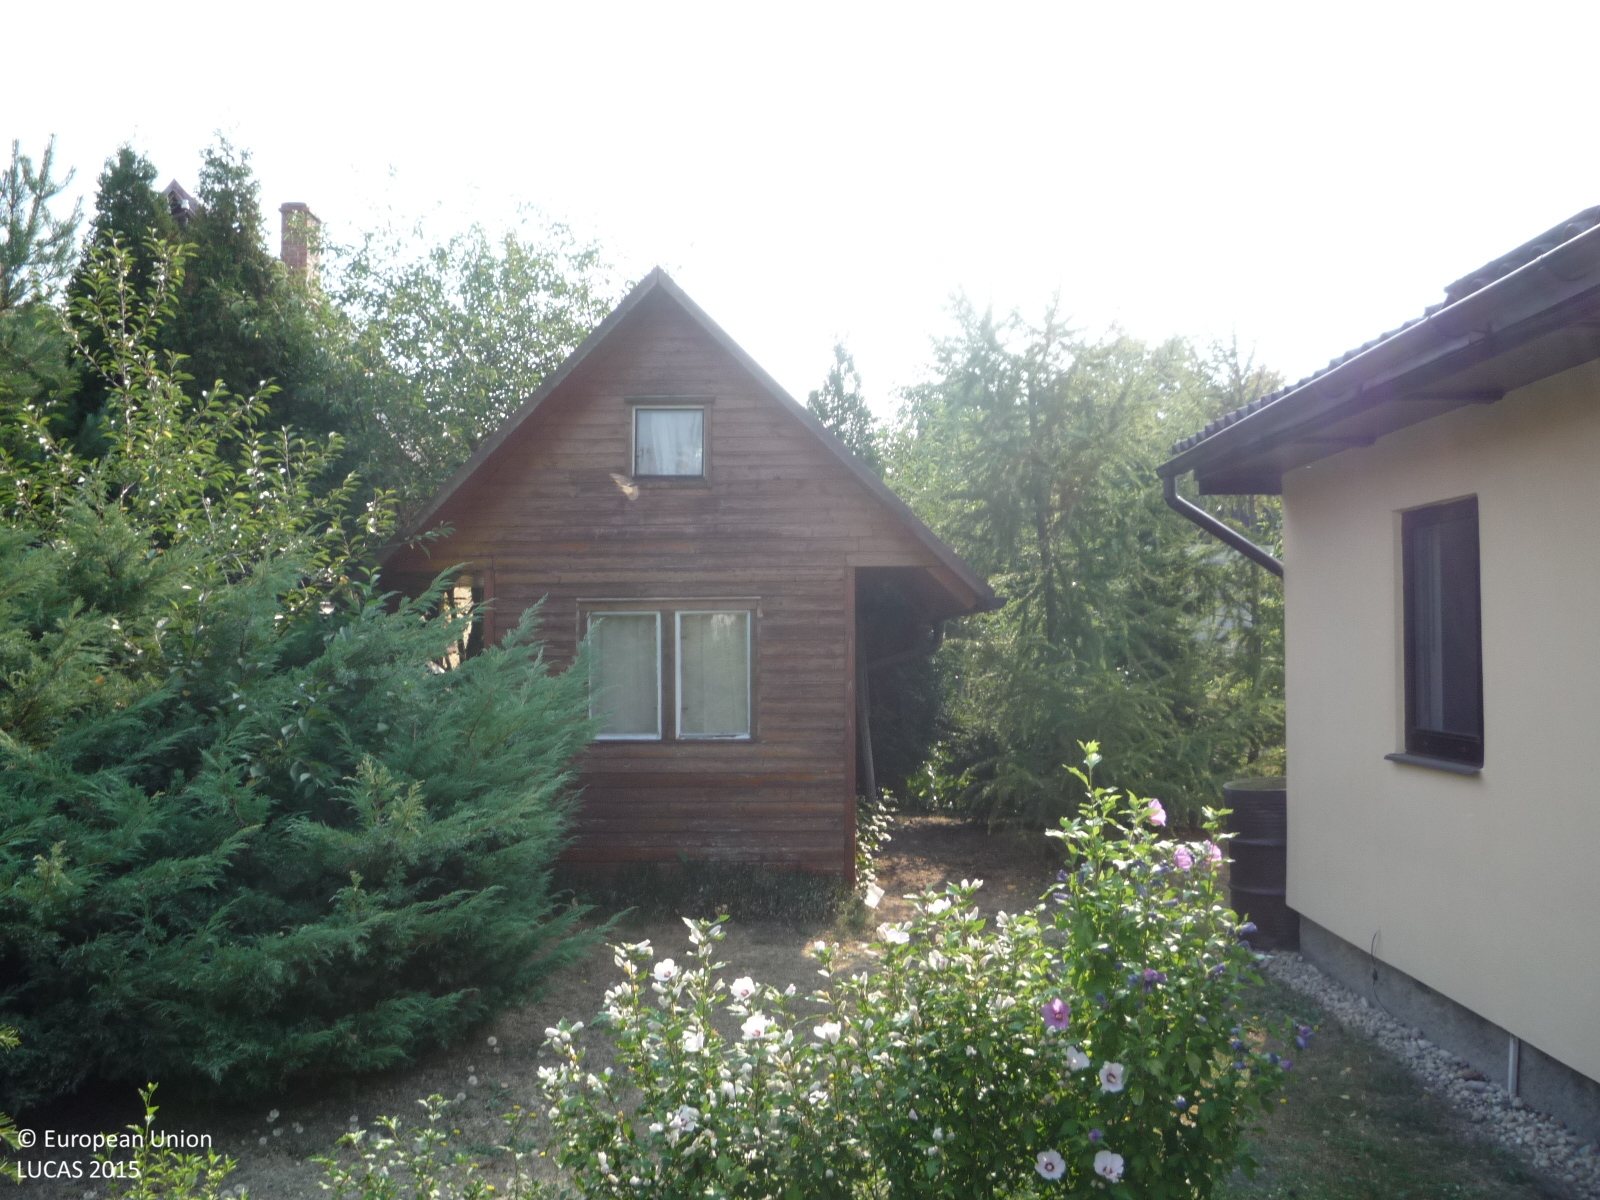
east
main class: Cropland
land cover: Apple fruit
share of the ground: 25 - 50 %
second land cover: Grassland without tree/shrub cover
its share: 50 - 75 %
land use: Kitchen garden
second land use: Amenities, museums, leisure
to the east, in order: Apple fruit; Grassland without tree/shrub cover; Artificial constructions in urban areas
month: August
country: CZ
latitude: 49.9039
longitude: 14.3315
